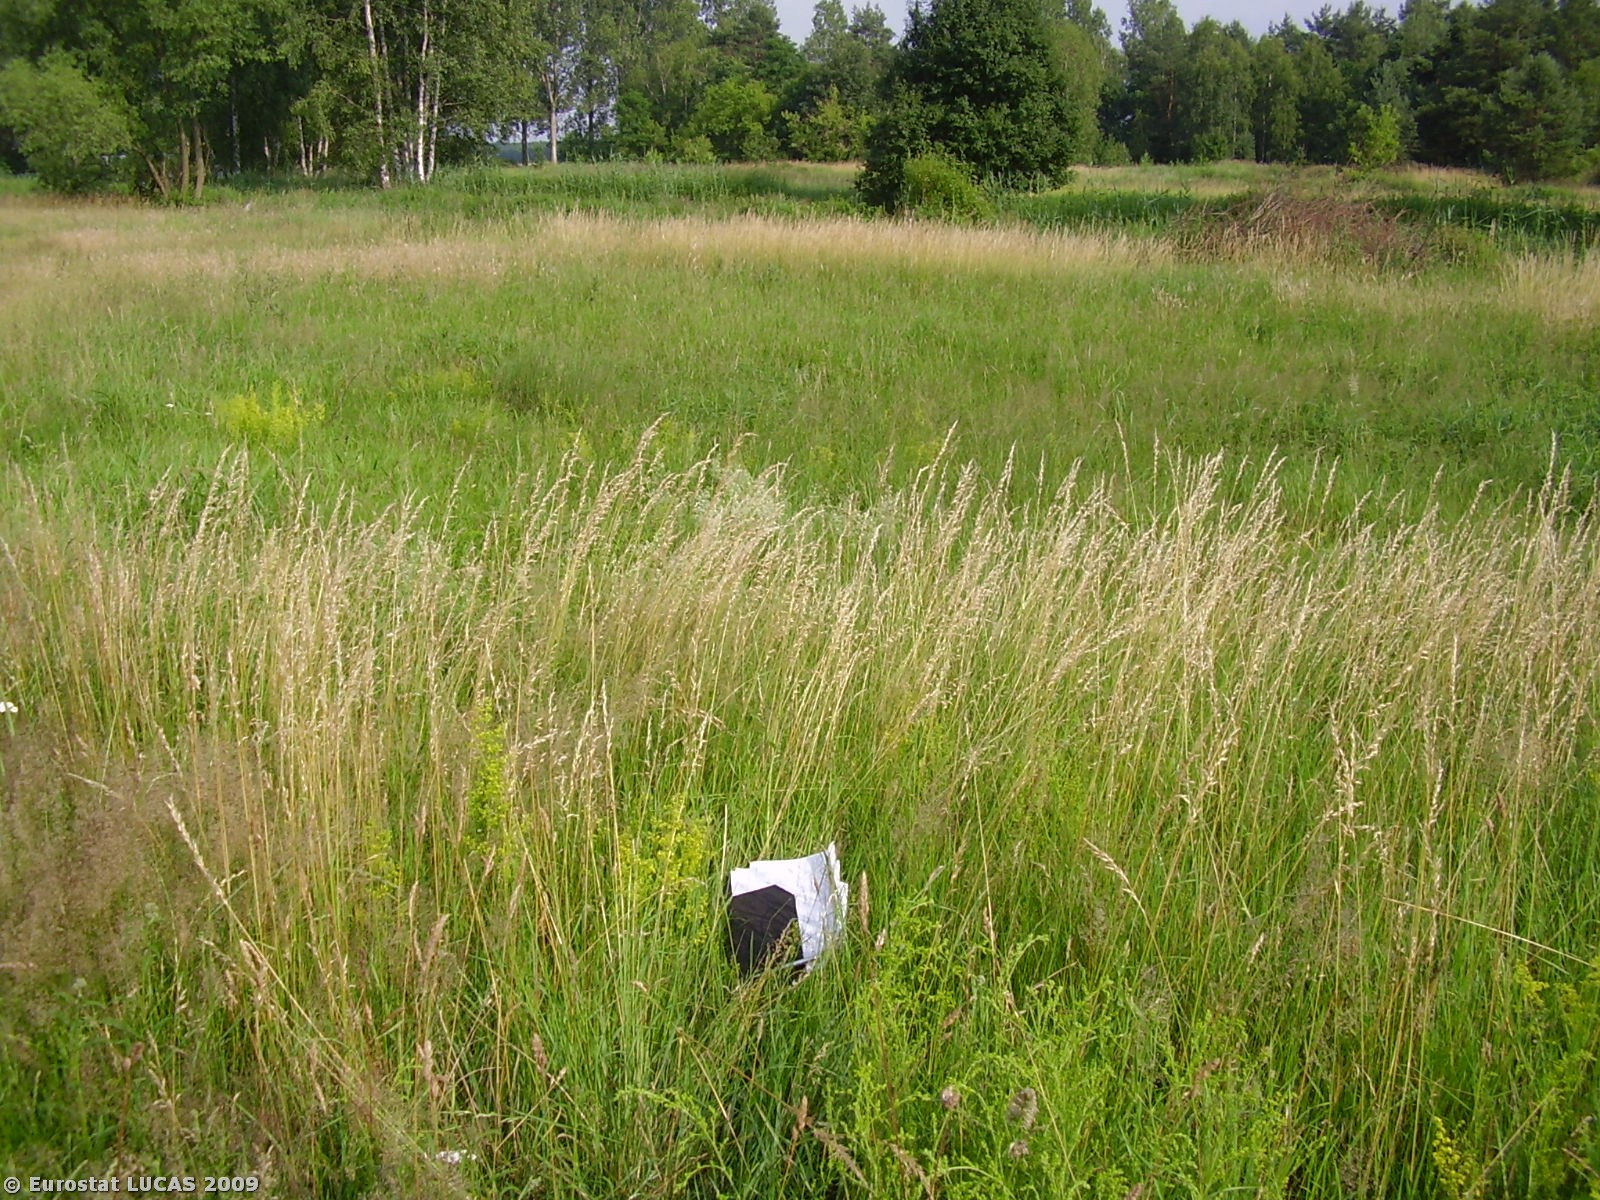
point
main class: Grassland
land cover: Grassland with sparse tree/shrub cover
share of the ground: > 75 %
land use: Unused
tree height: > 5 m
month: June
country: PL
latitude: 51.7129
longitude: 16.1575
